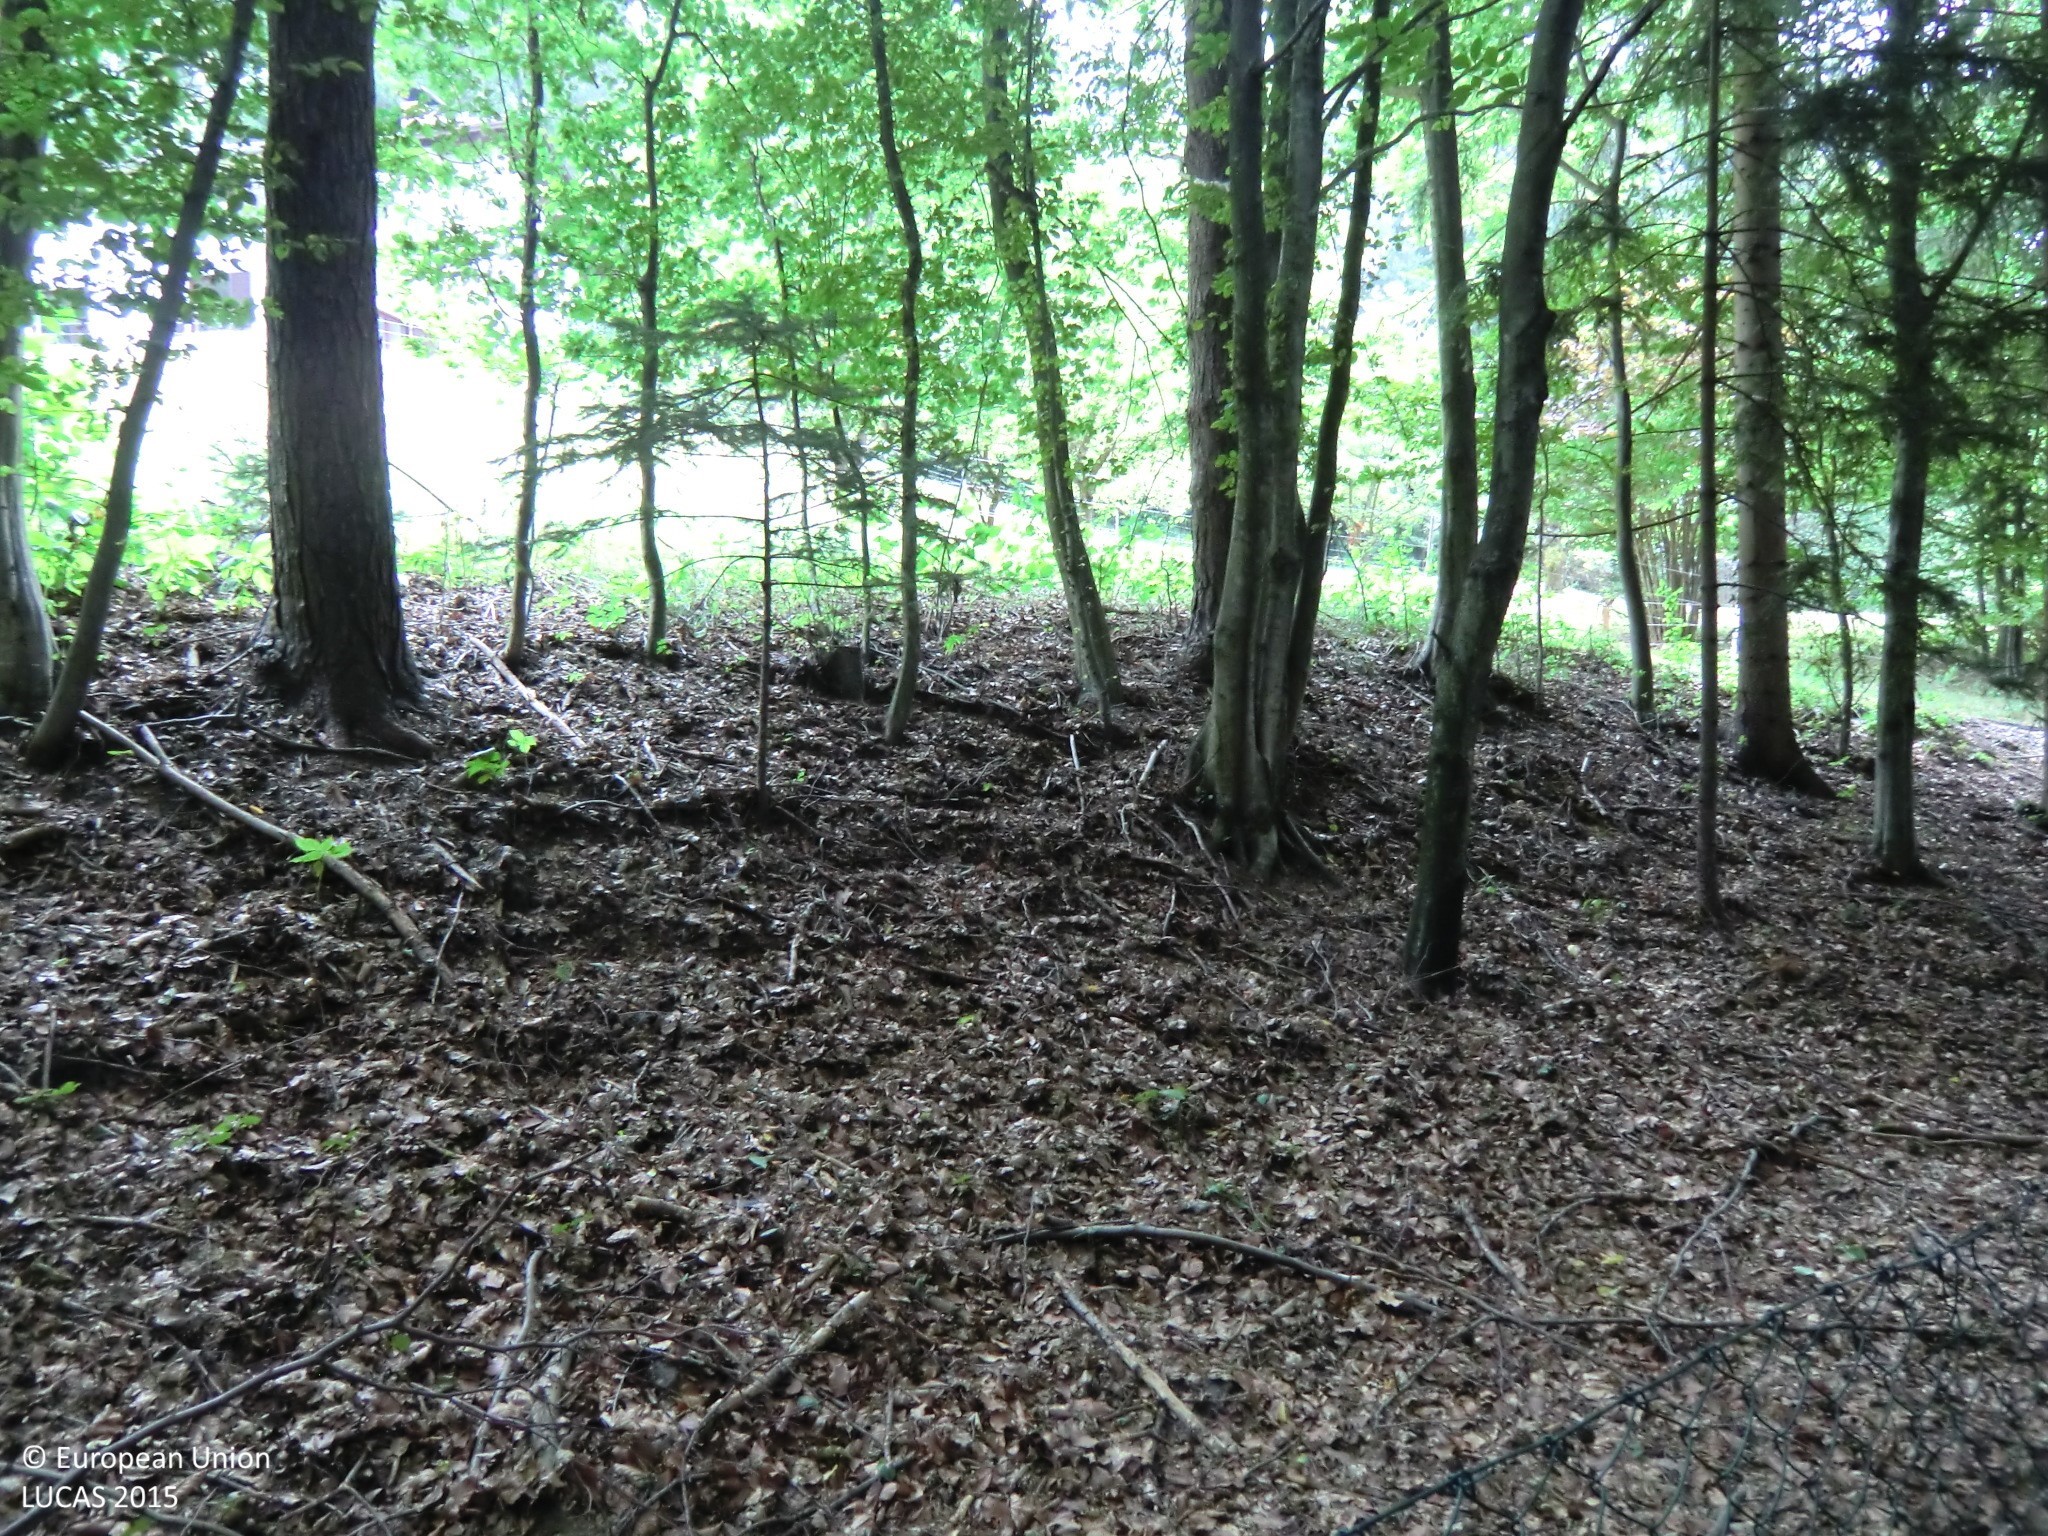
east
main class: Grassland
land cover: Grassland without tree/shrub cover
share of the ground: > 75 %
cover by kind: herbaceous plants 100 %
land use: Residential
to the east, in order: Grassland without tree/shrub cover; Artificial constructions in urban areas; Broadleaved woodland; Tracks; Broadleaved woodland; Grassland without tree/shrub cover; Single bushes/trees; Grassland without tree/shrub cover; Tracks; Grassland without tree/shrub cover; Broadleaved woodland; Grassland without tree/shrub cover
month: July
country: AT
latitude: 47.1330
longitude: 15.4449
